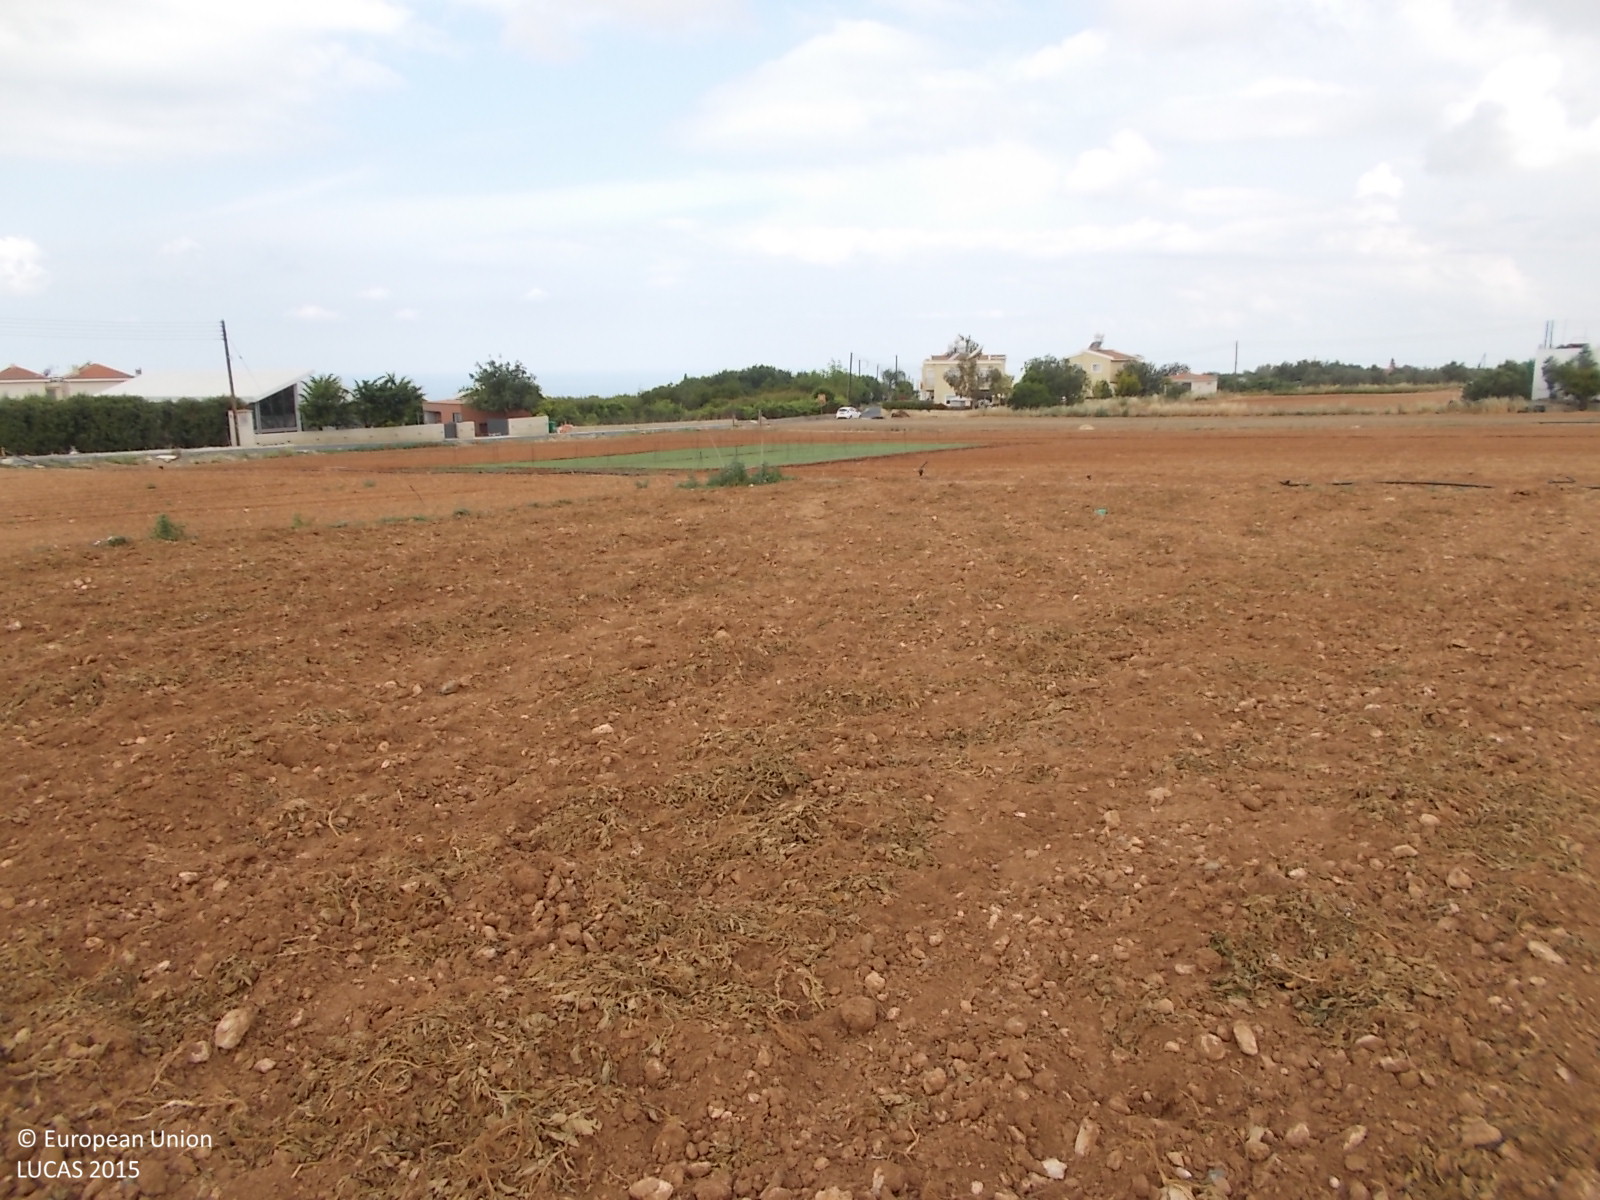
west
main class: Cropland
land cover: Potatoes
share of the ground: < 10 %
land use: Agriculture (excluding fallow land and kitchen gardens)
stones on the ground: < 10 %
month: May
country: CY
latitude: 34.8056
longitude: 32.4344
